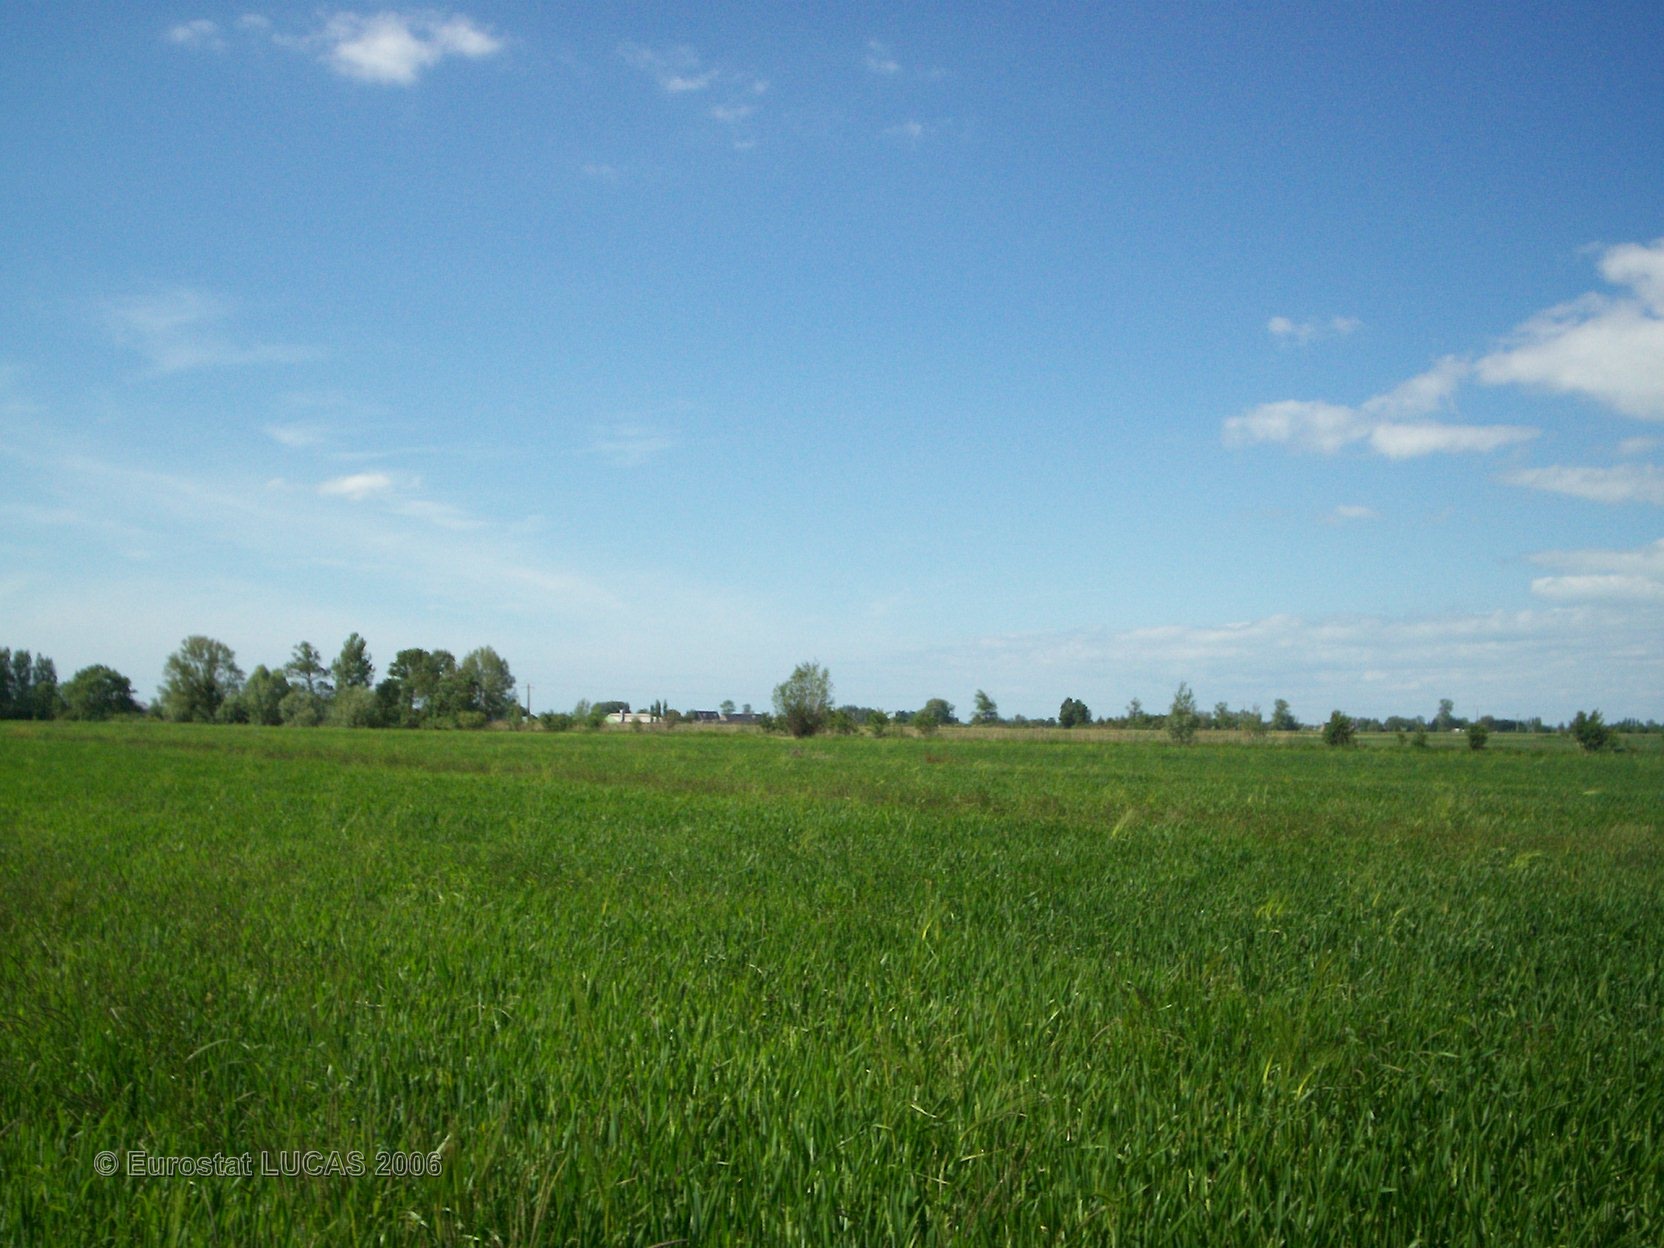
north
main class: Cropland
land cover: Common wheat
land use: Agriculture (excluding fallow land and kitchen gardens)
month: May
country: FR
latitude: 48.5776
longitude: -1.7207
